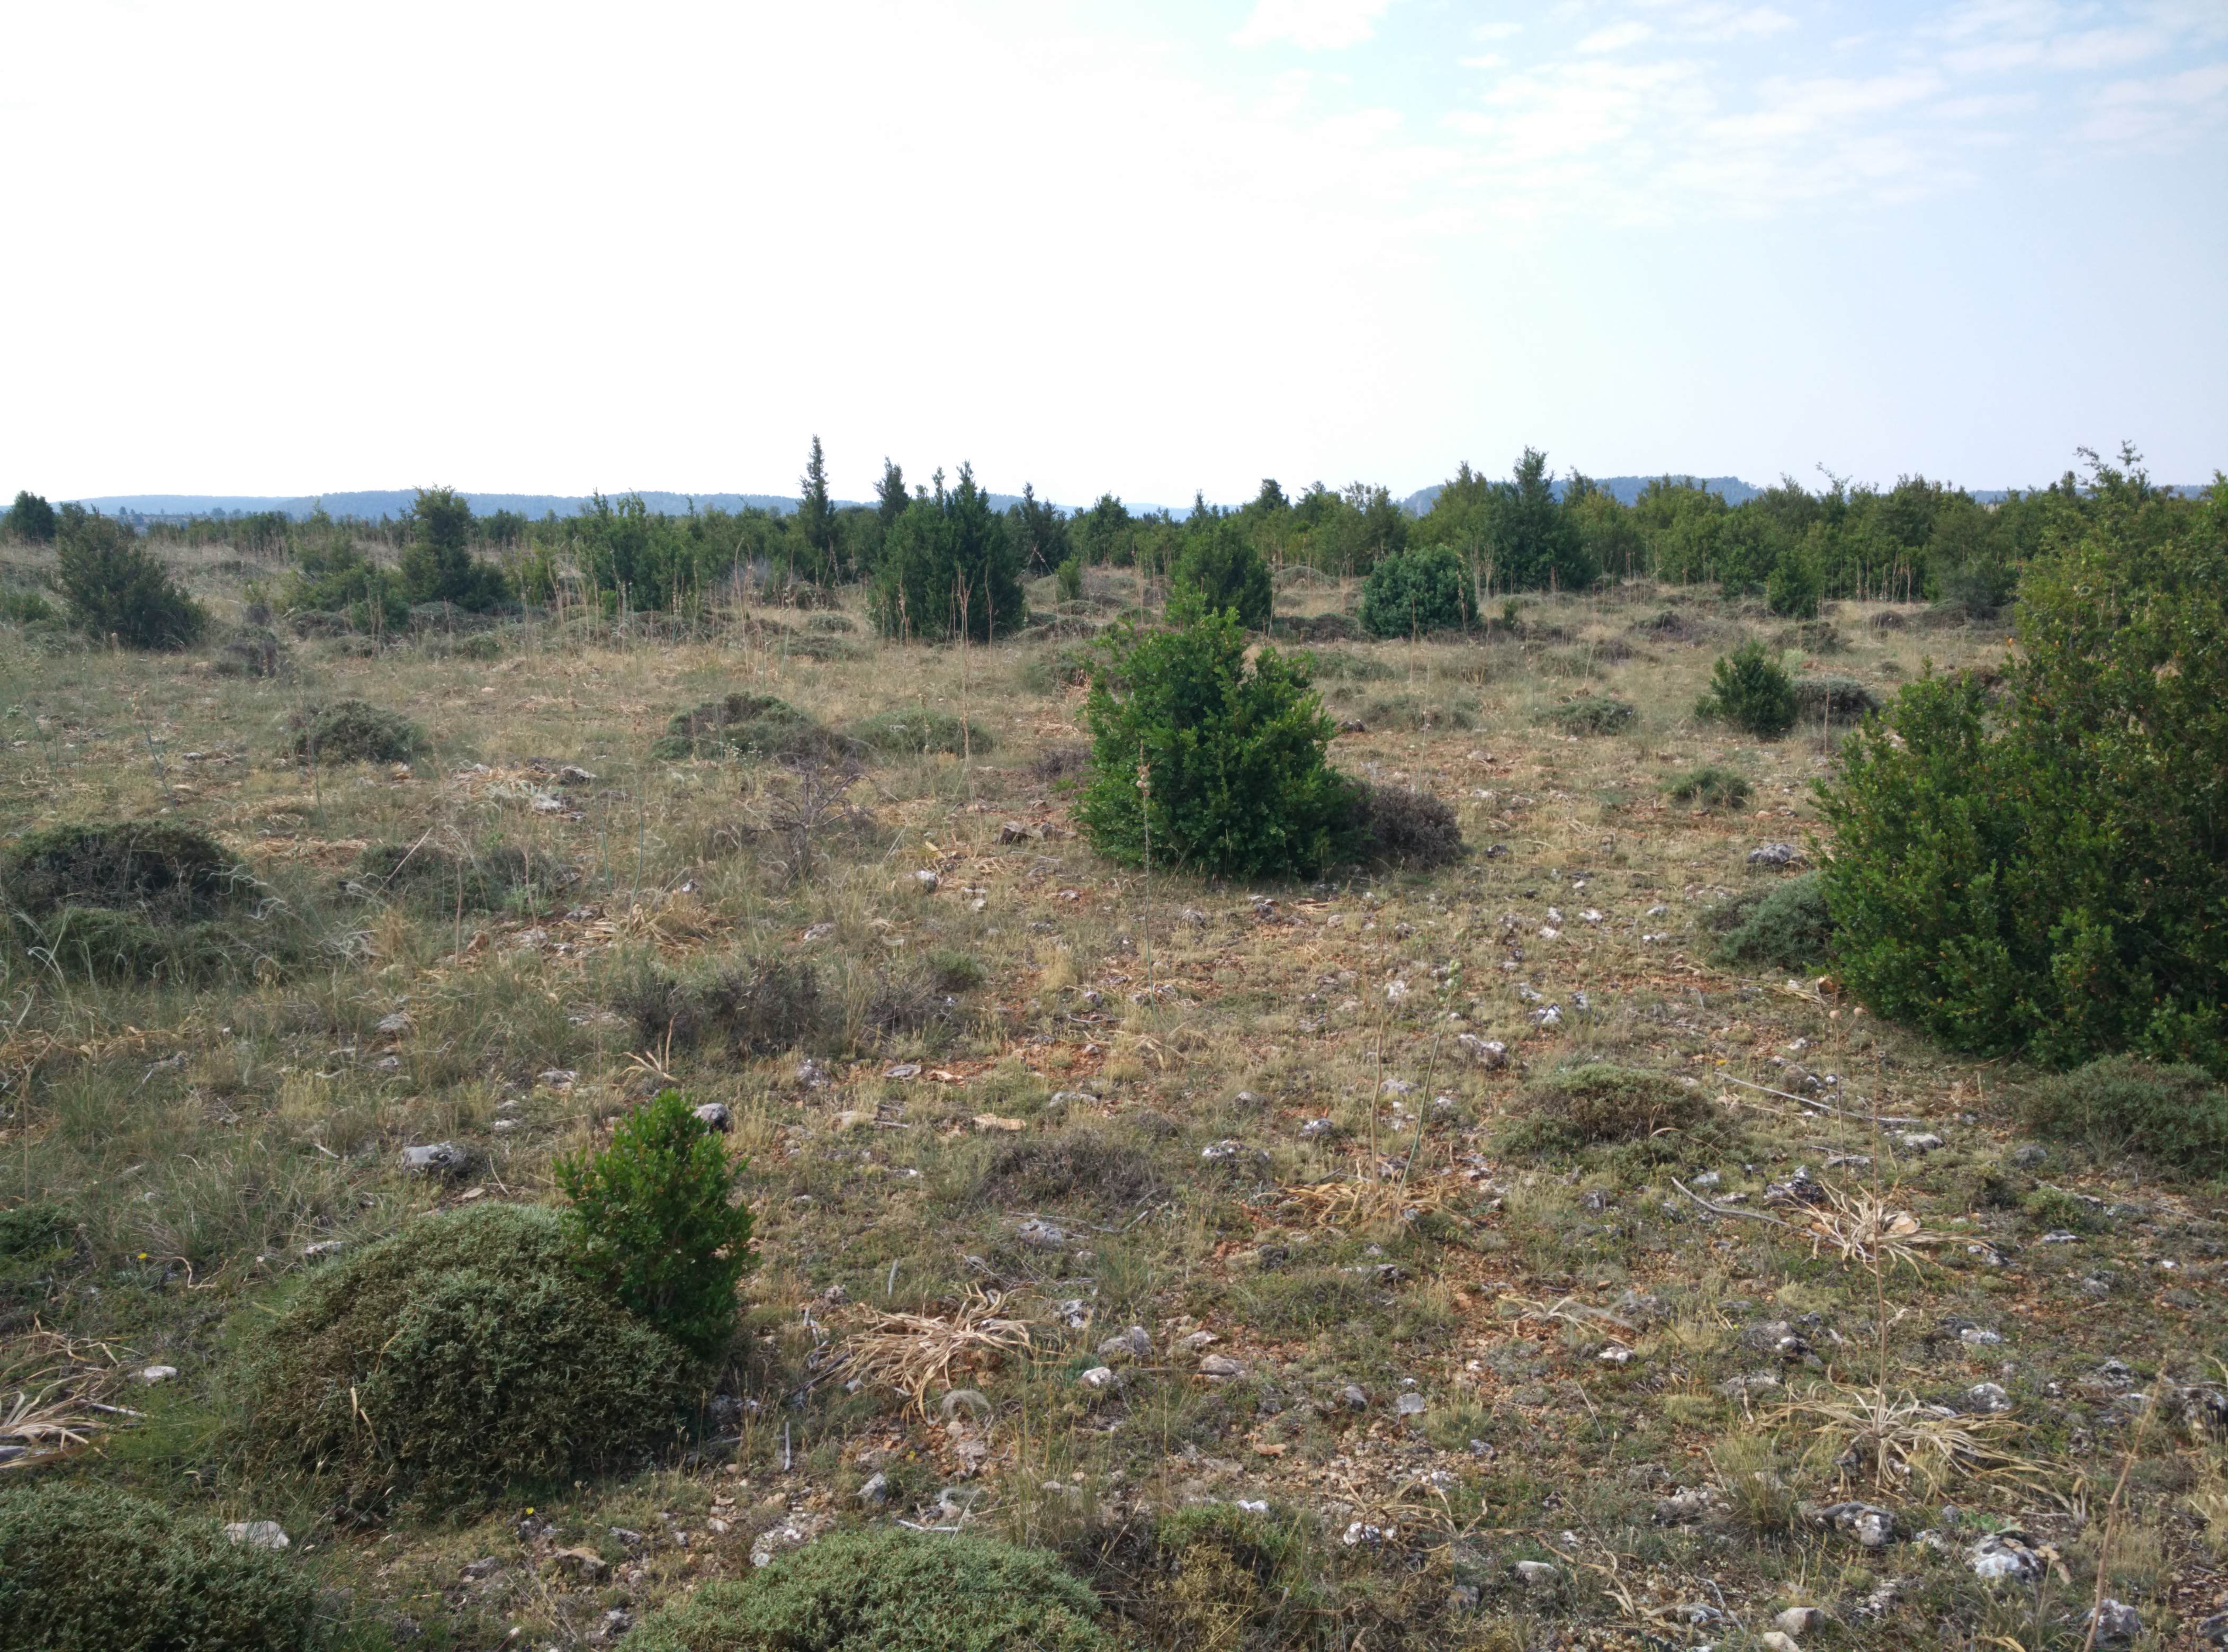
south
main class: Shrubland
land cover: Shrubland without tree cover
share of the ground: 50 - 75 %
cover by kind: shrubs 60 %, unconsolidated bare surface 35 %, herbaceous plants 5 %
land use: Semi-natural and natural areas not in use
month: June
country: ES
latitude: 40.6986
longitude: -1.9865
